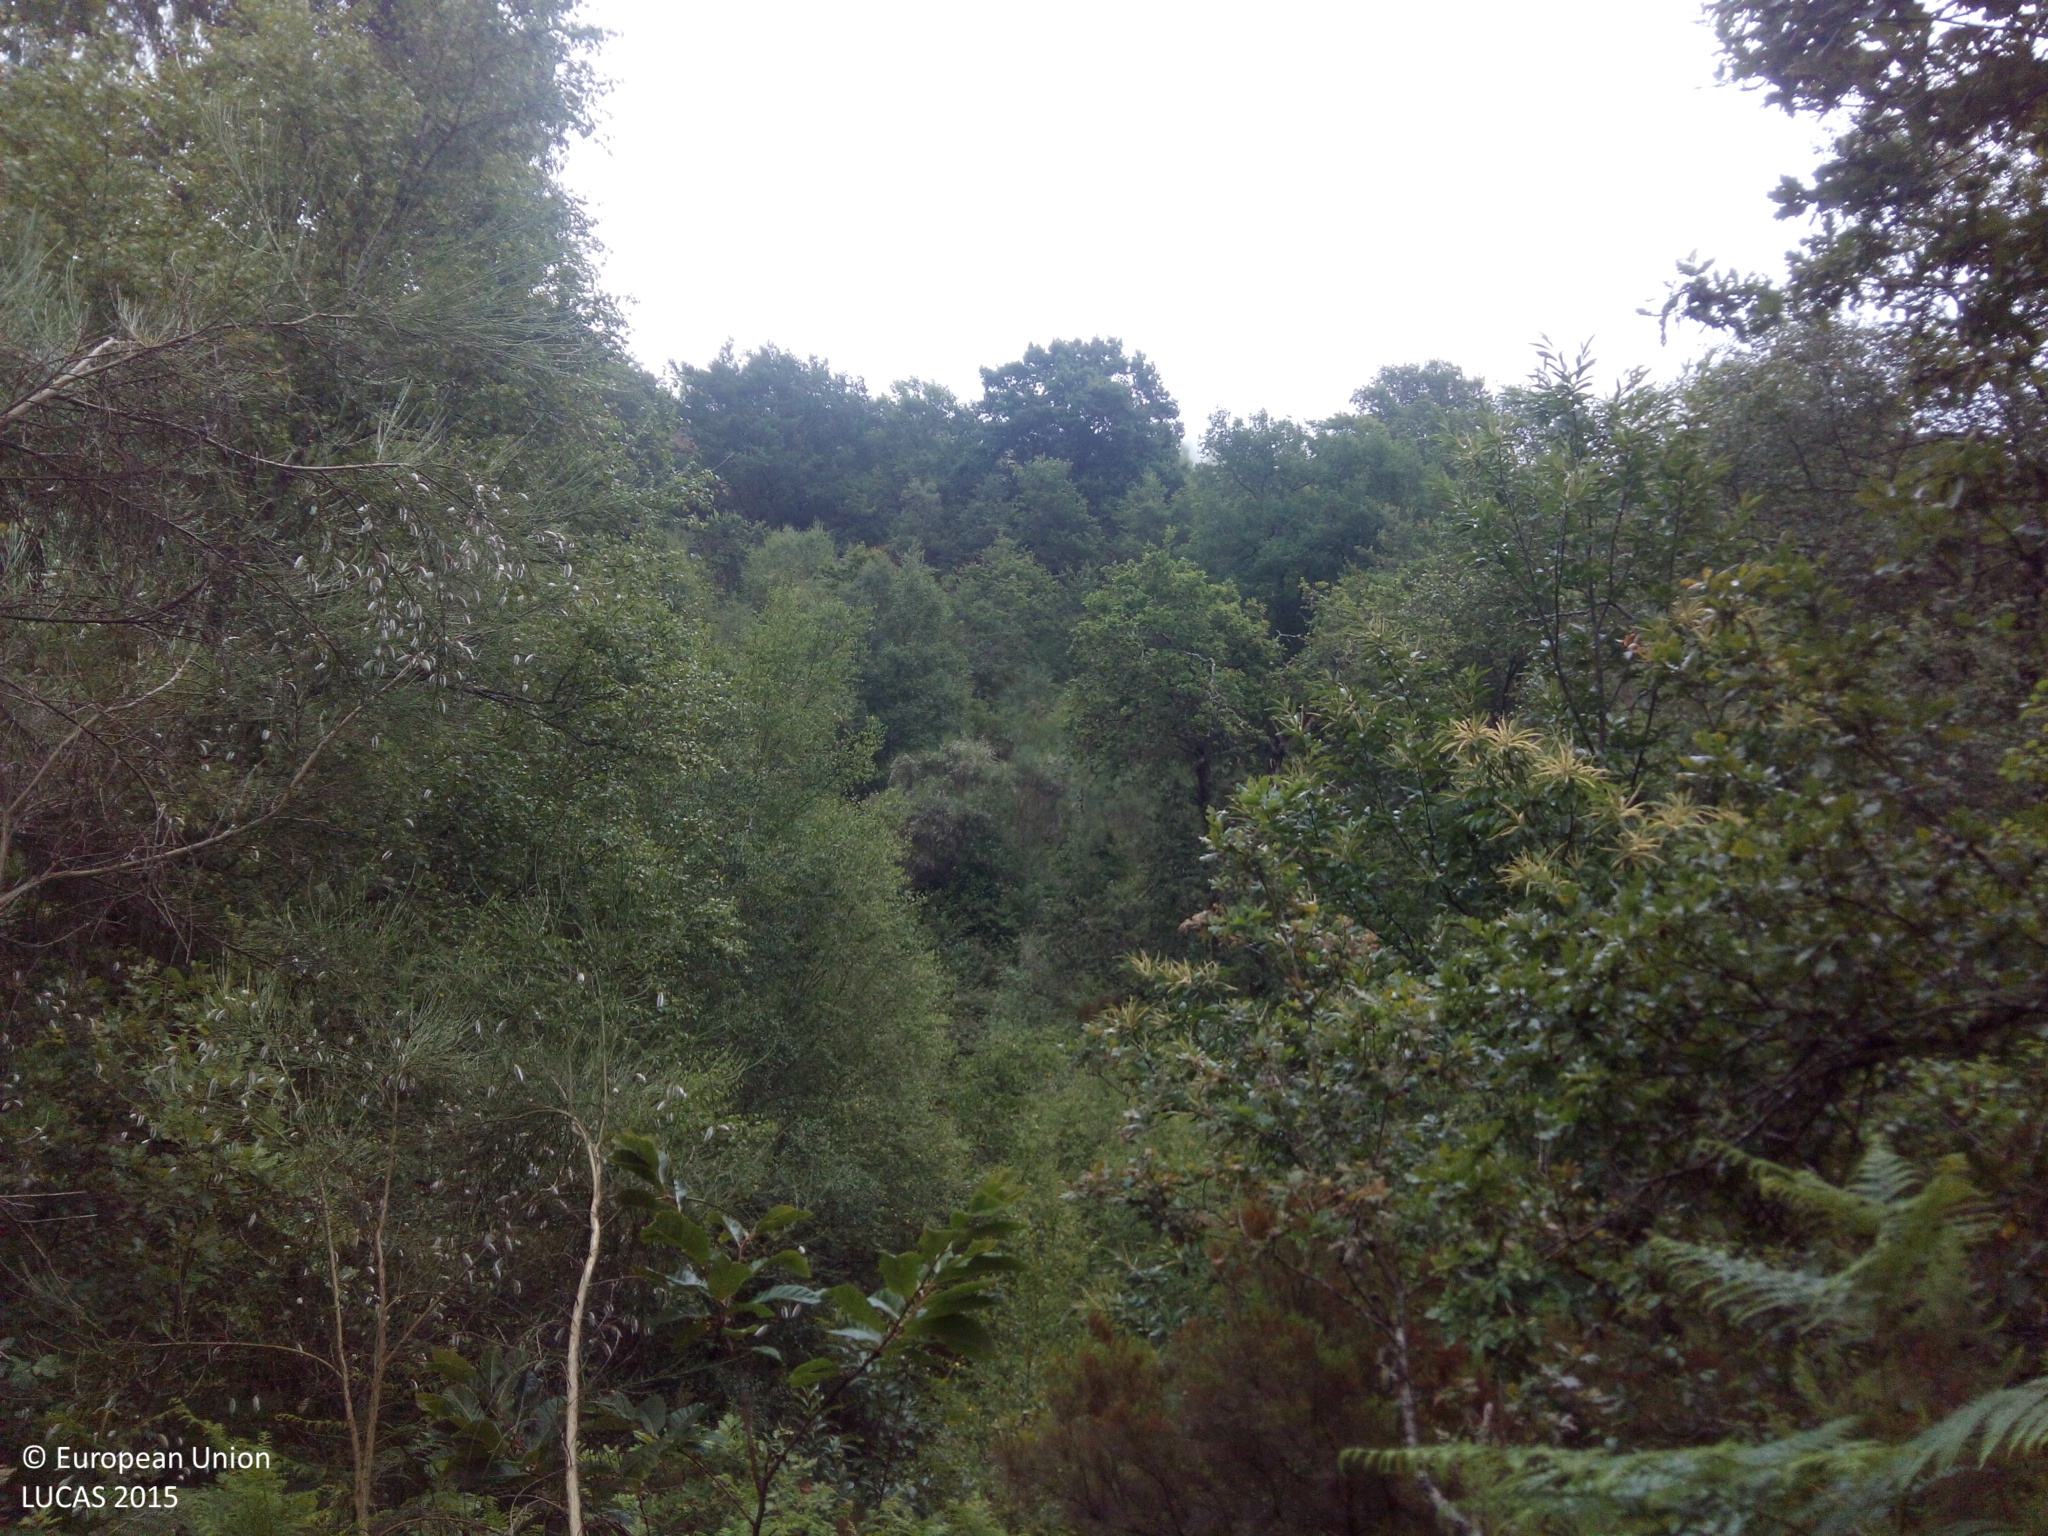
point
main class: Shrubland
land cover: Shrubland with sparse tree cover
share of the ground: > 75 %
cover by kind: shrubs 95 %, coniferous forest trees 5 %
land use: Forestry
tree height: > 5 m
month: July
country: ES
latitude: 42.2655
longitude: -8.2854
